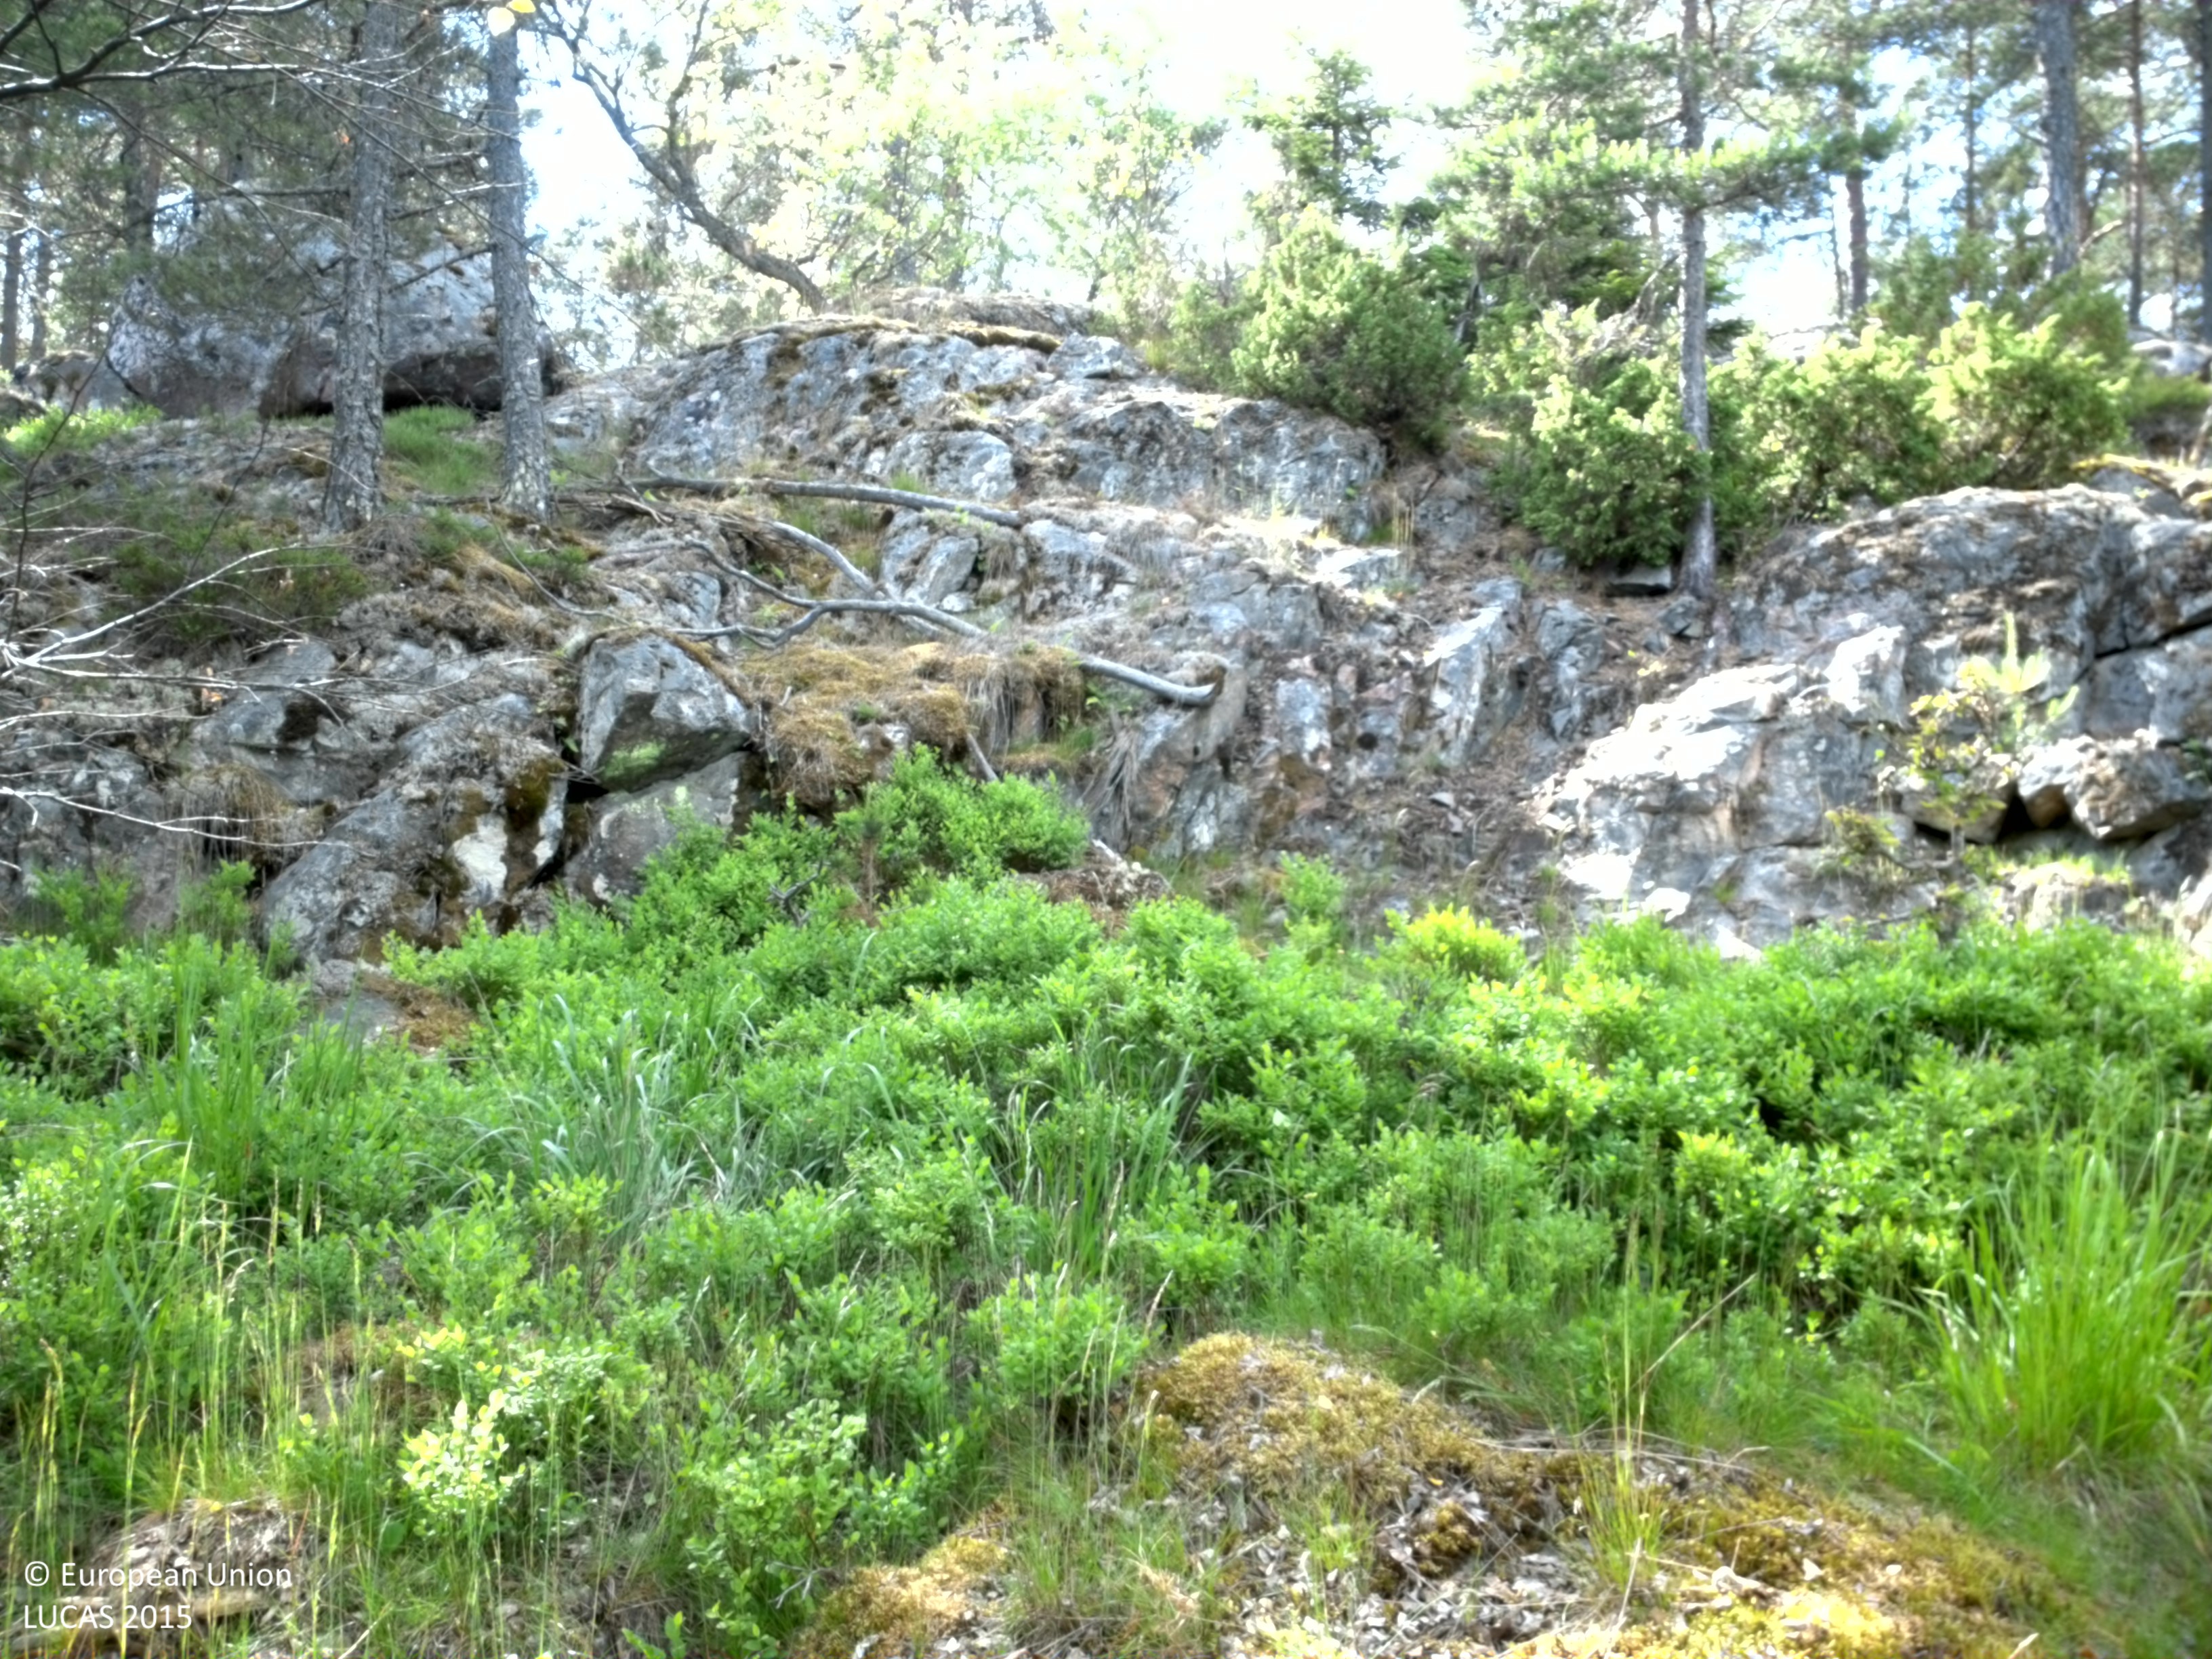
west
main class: Woodland
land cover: Pine dominated coniferous woodland
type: boreal forest
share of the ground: 10 - 25 %
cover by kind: shrubs 50 %, coniferous forest trees 20 %, lichens and mosses 20 %, broadleaved forest trees 5 %, herbaceous plants 5 %
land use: Forestry
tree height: < 5 m
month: June
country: SE
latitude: 58.6843
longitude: 16.3257
